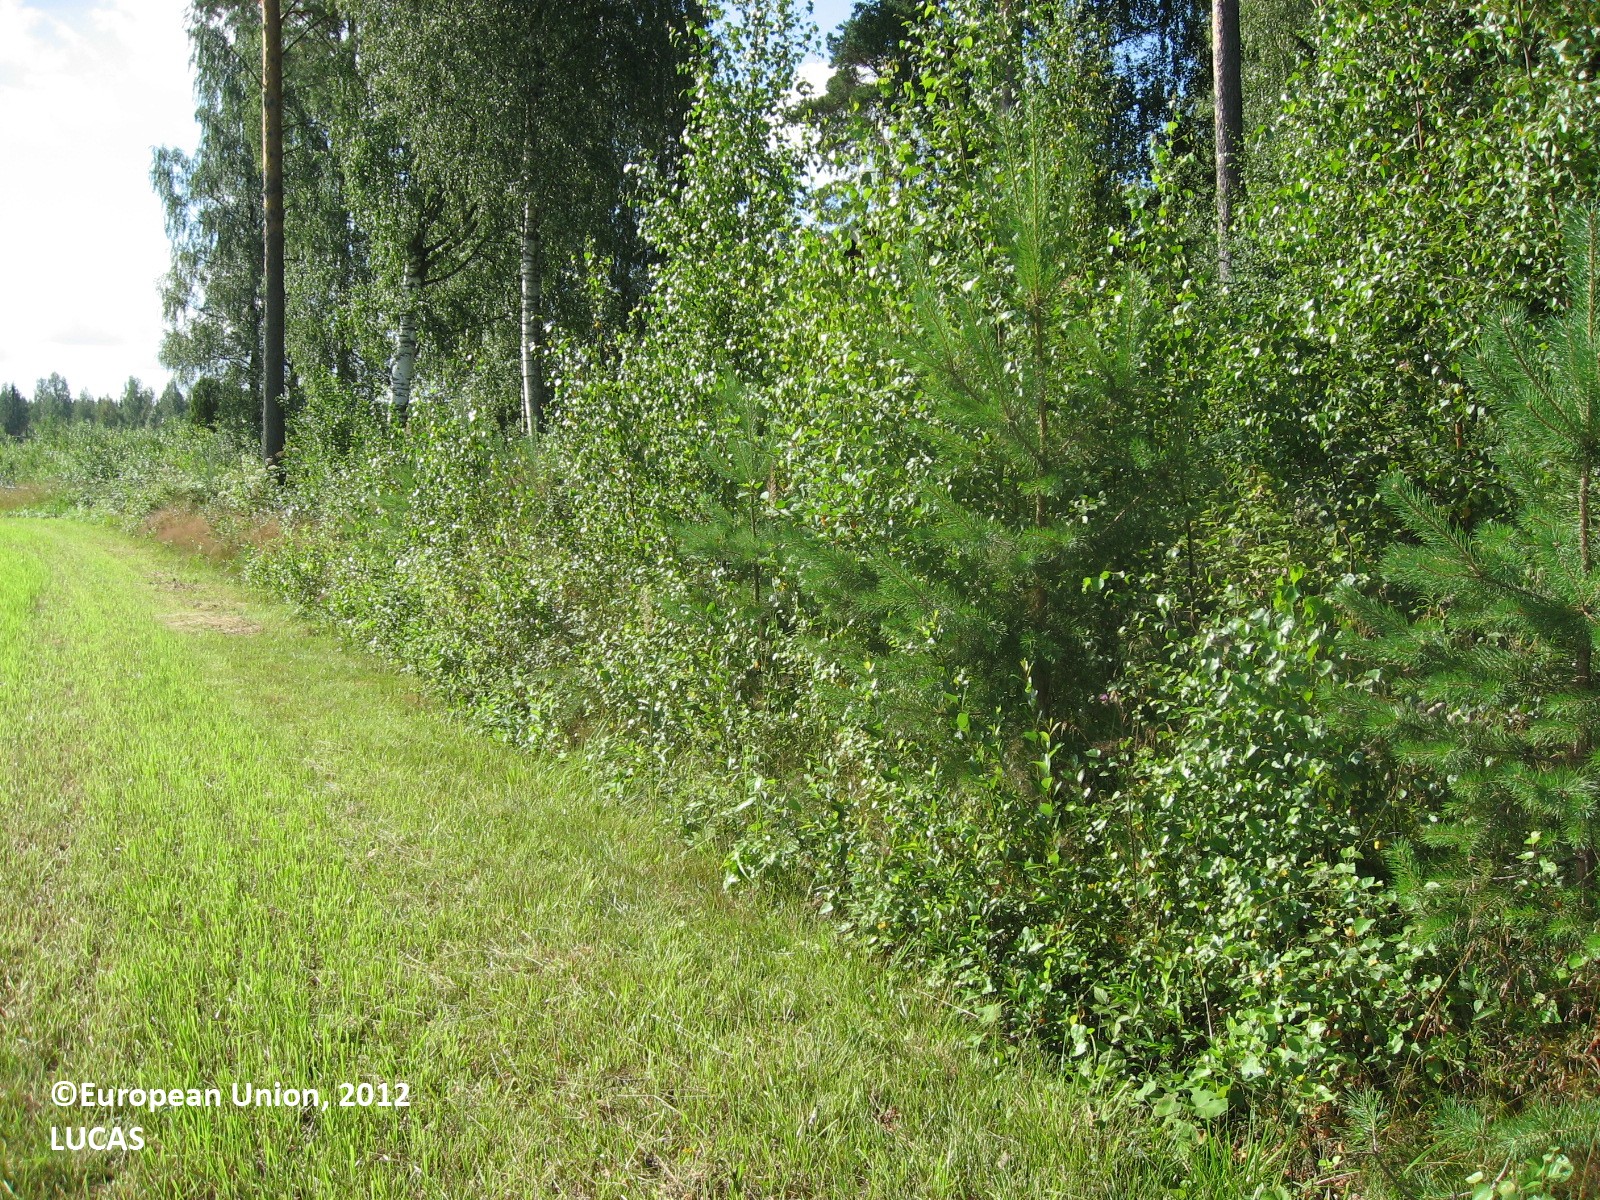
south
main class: Cropland
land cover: Temporary grasslands
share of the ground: > 75 %
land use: Agriculture (excluding fallow land and kitchen gardens)
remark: Harvested field
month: July
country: FI
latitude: 61.2837
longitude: 26.5123
